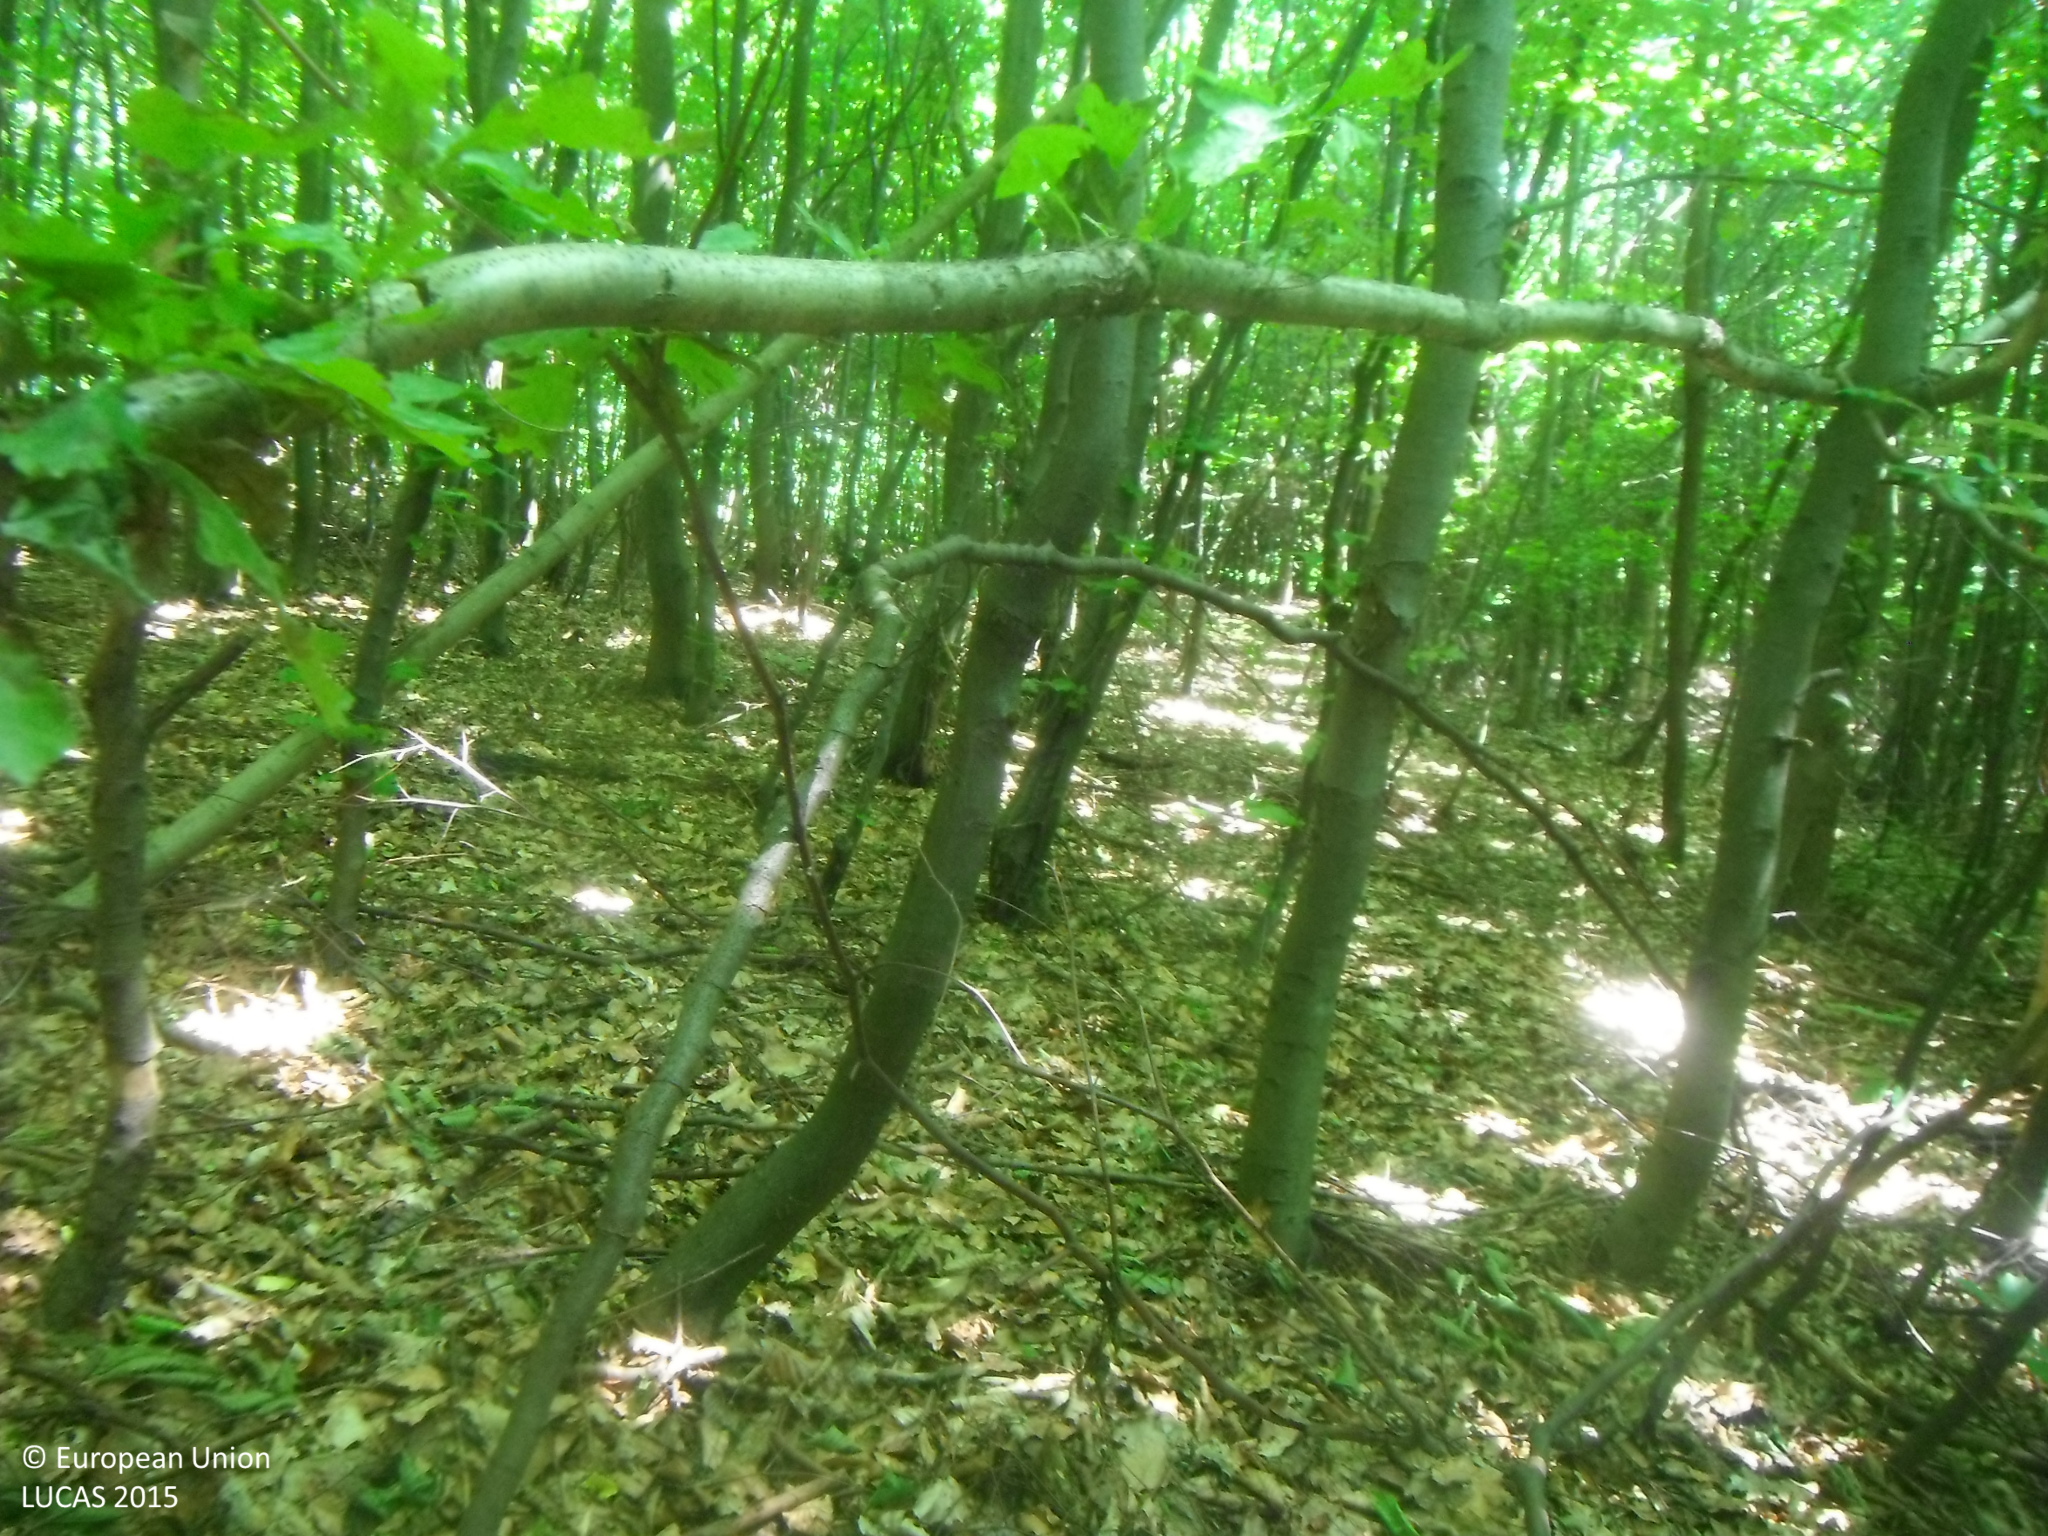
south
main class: Woodland
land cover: Broadleaved woodland
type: beech forest
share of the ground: > 75 %
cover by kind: broadleaved forest trees 95 %, herbaceous plants 5 %
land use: Forestry
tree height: > 5 m
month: June
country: SK
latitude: 49.0287
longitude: 21.5790
